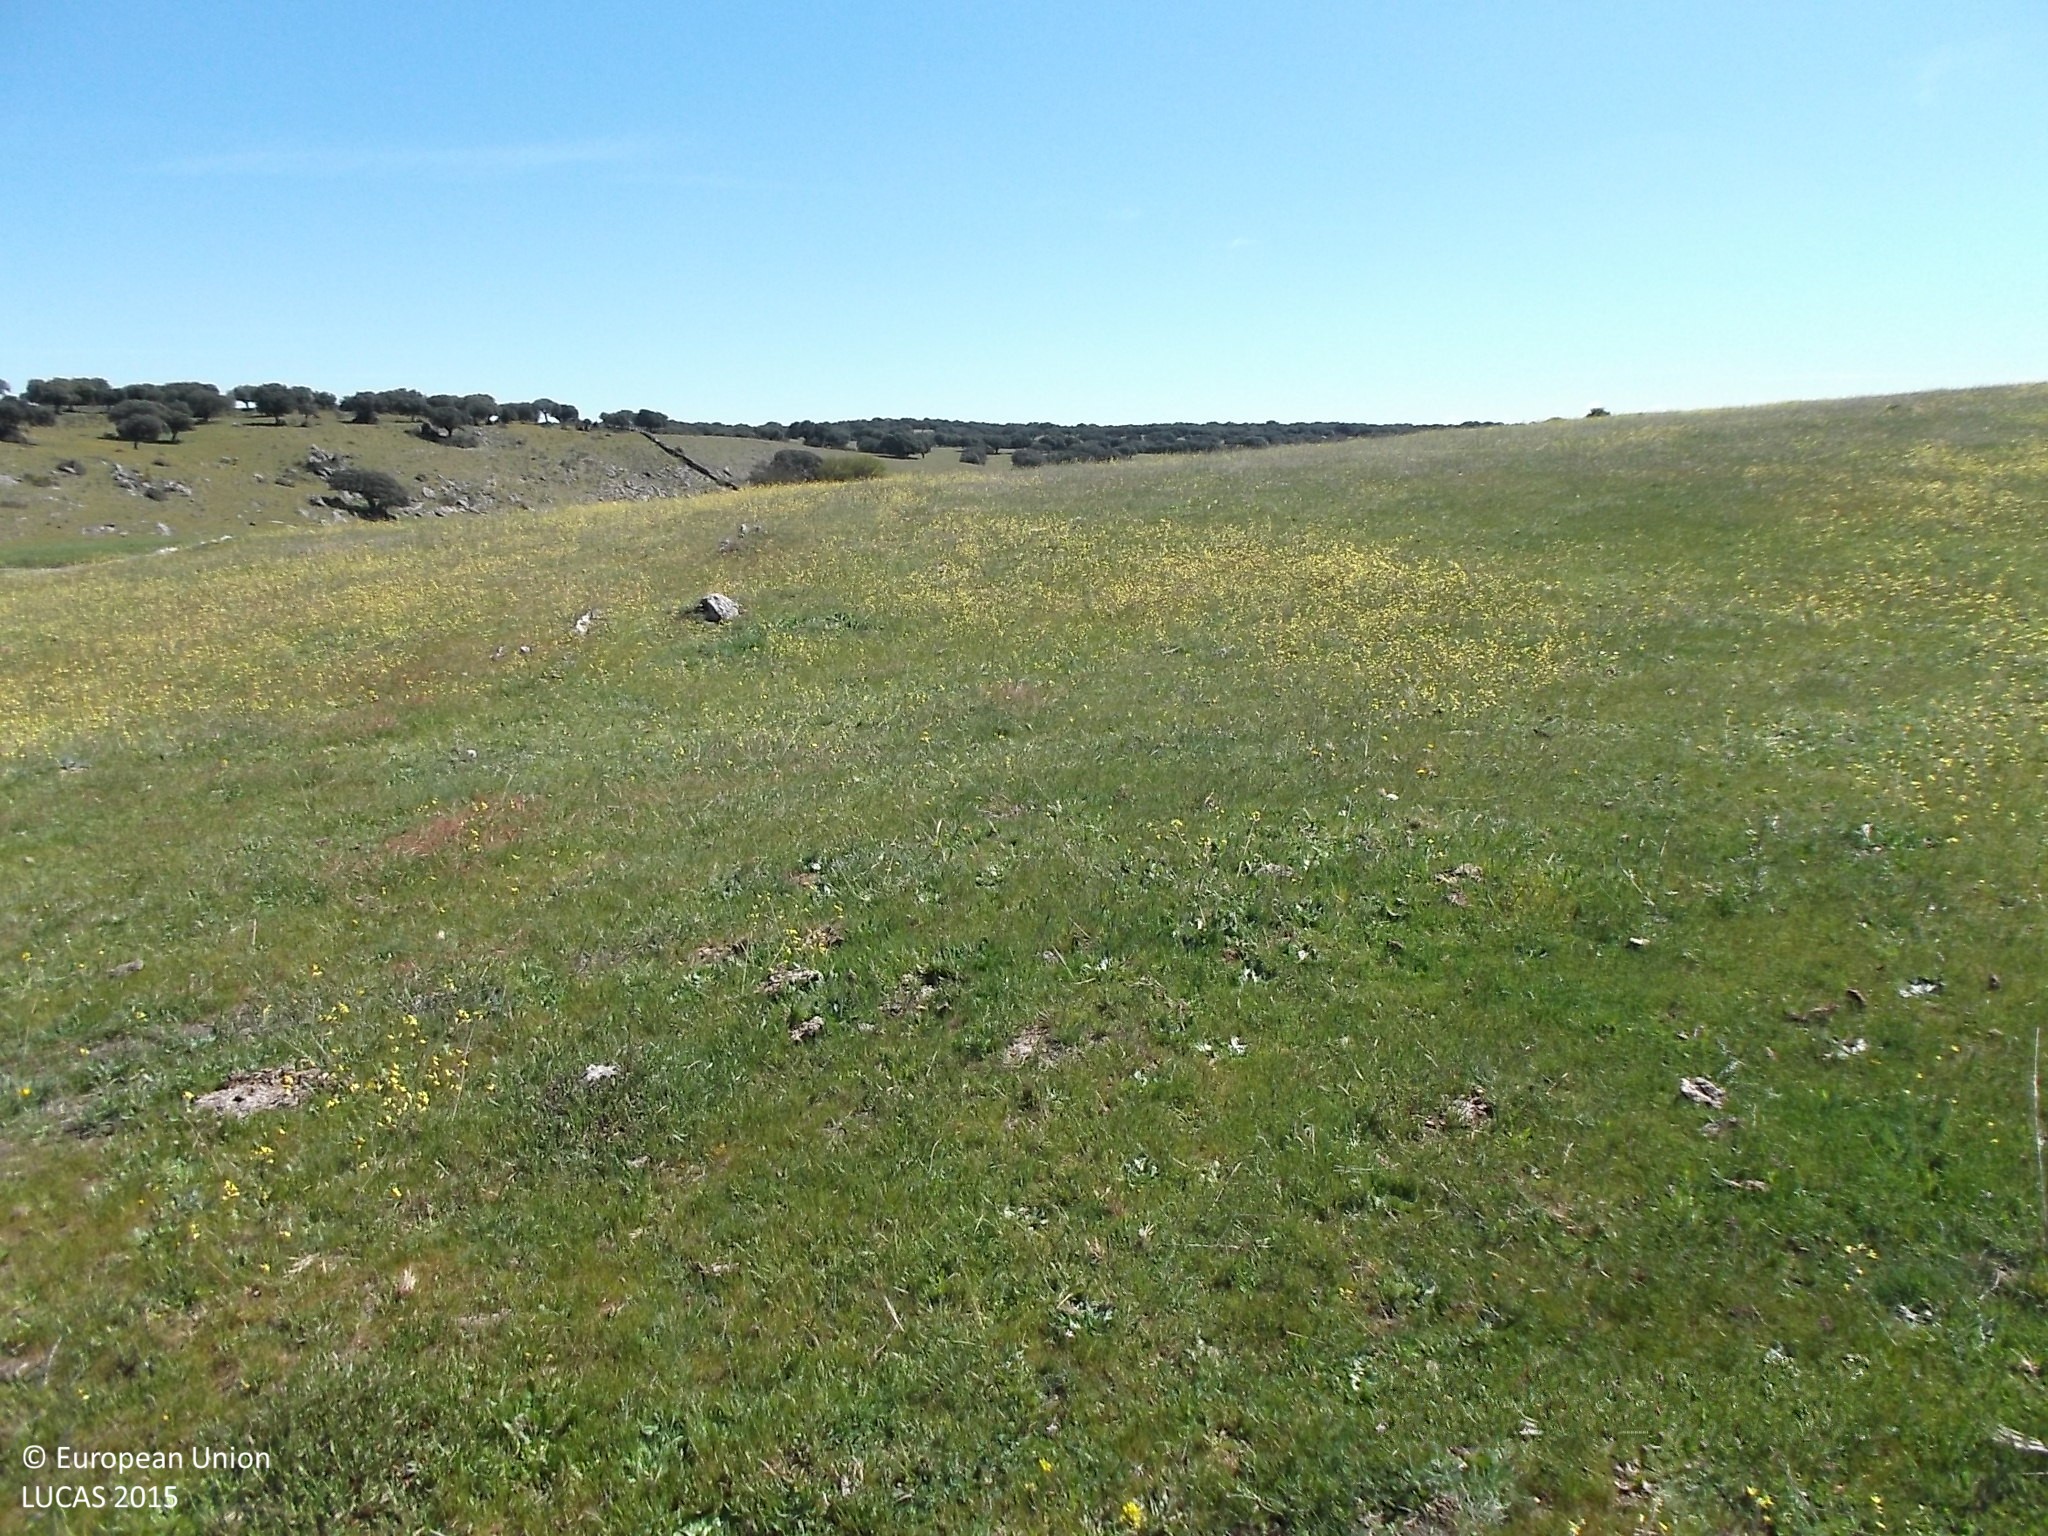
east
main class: Grassland
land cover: Grassland without tree/shrub cover
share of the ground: > 75 %
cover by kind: herbaceous plants 100 %
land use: Agriculture (excluding fallow land and kitchen gardens)
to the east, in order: Grassland without tree/shrub cover; Dry stone walls; Fences; Grassland without tree/shrub cover
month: April
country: ES
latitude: 41.0508
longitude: -5.9436
